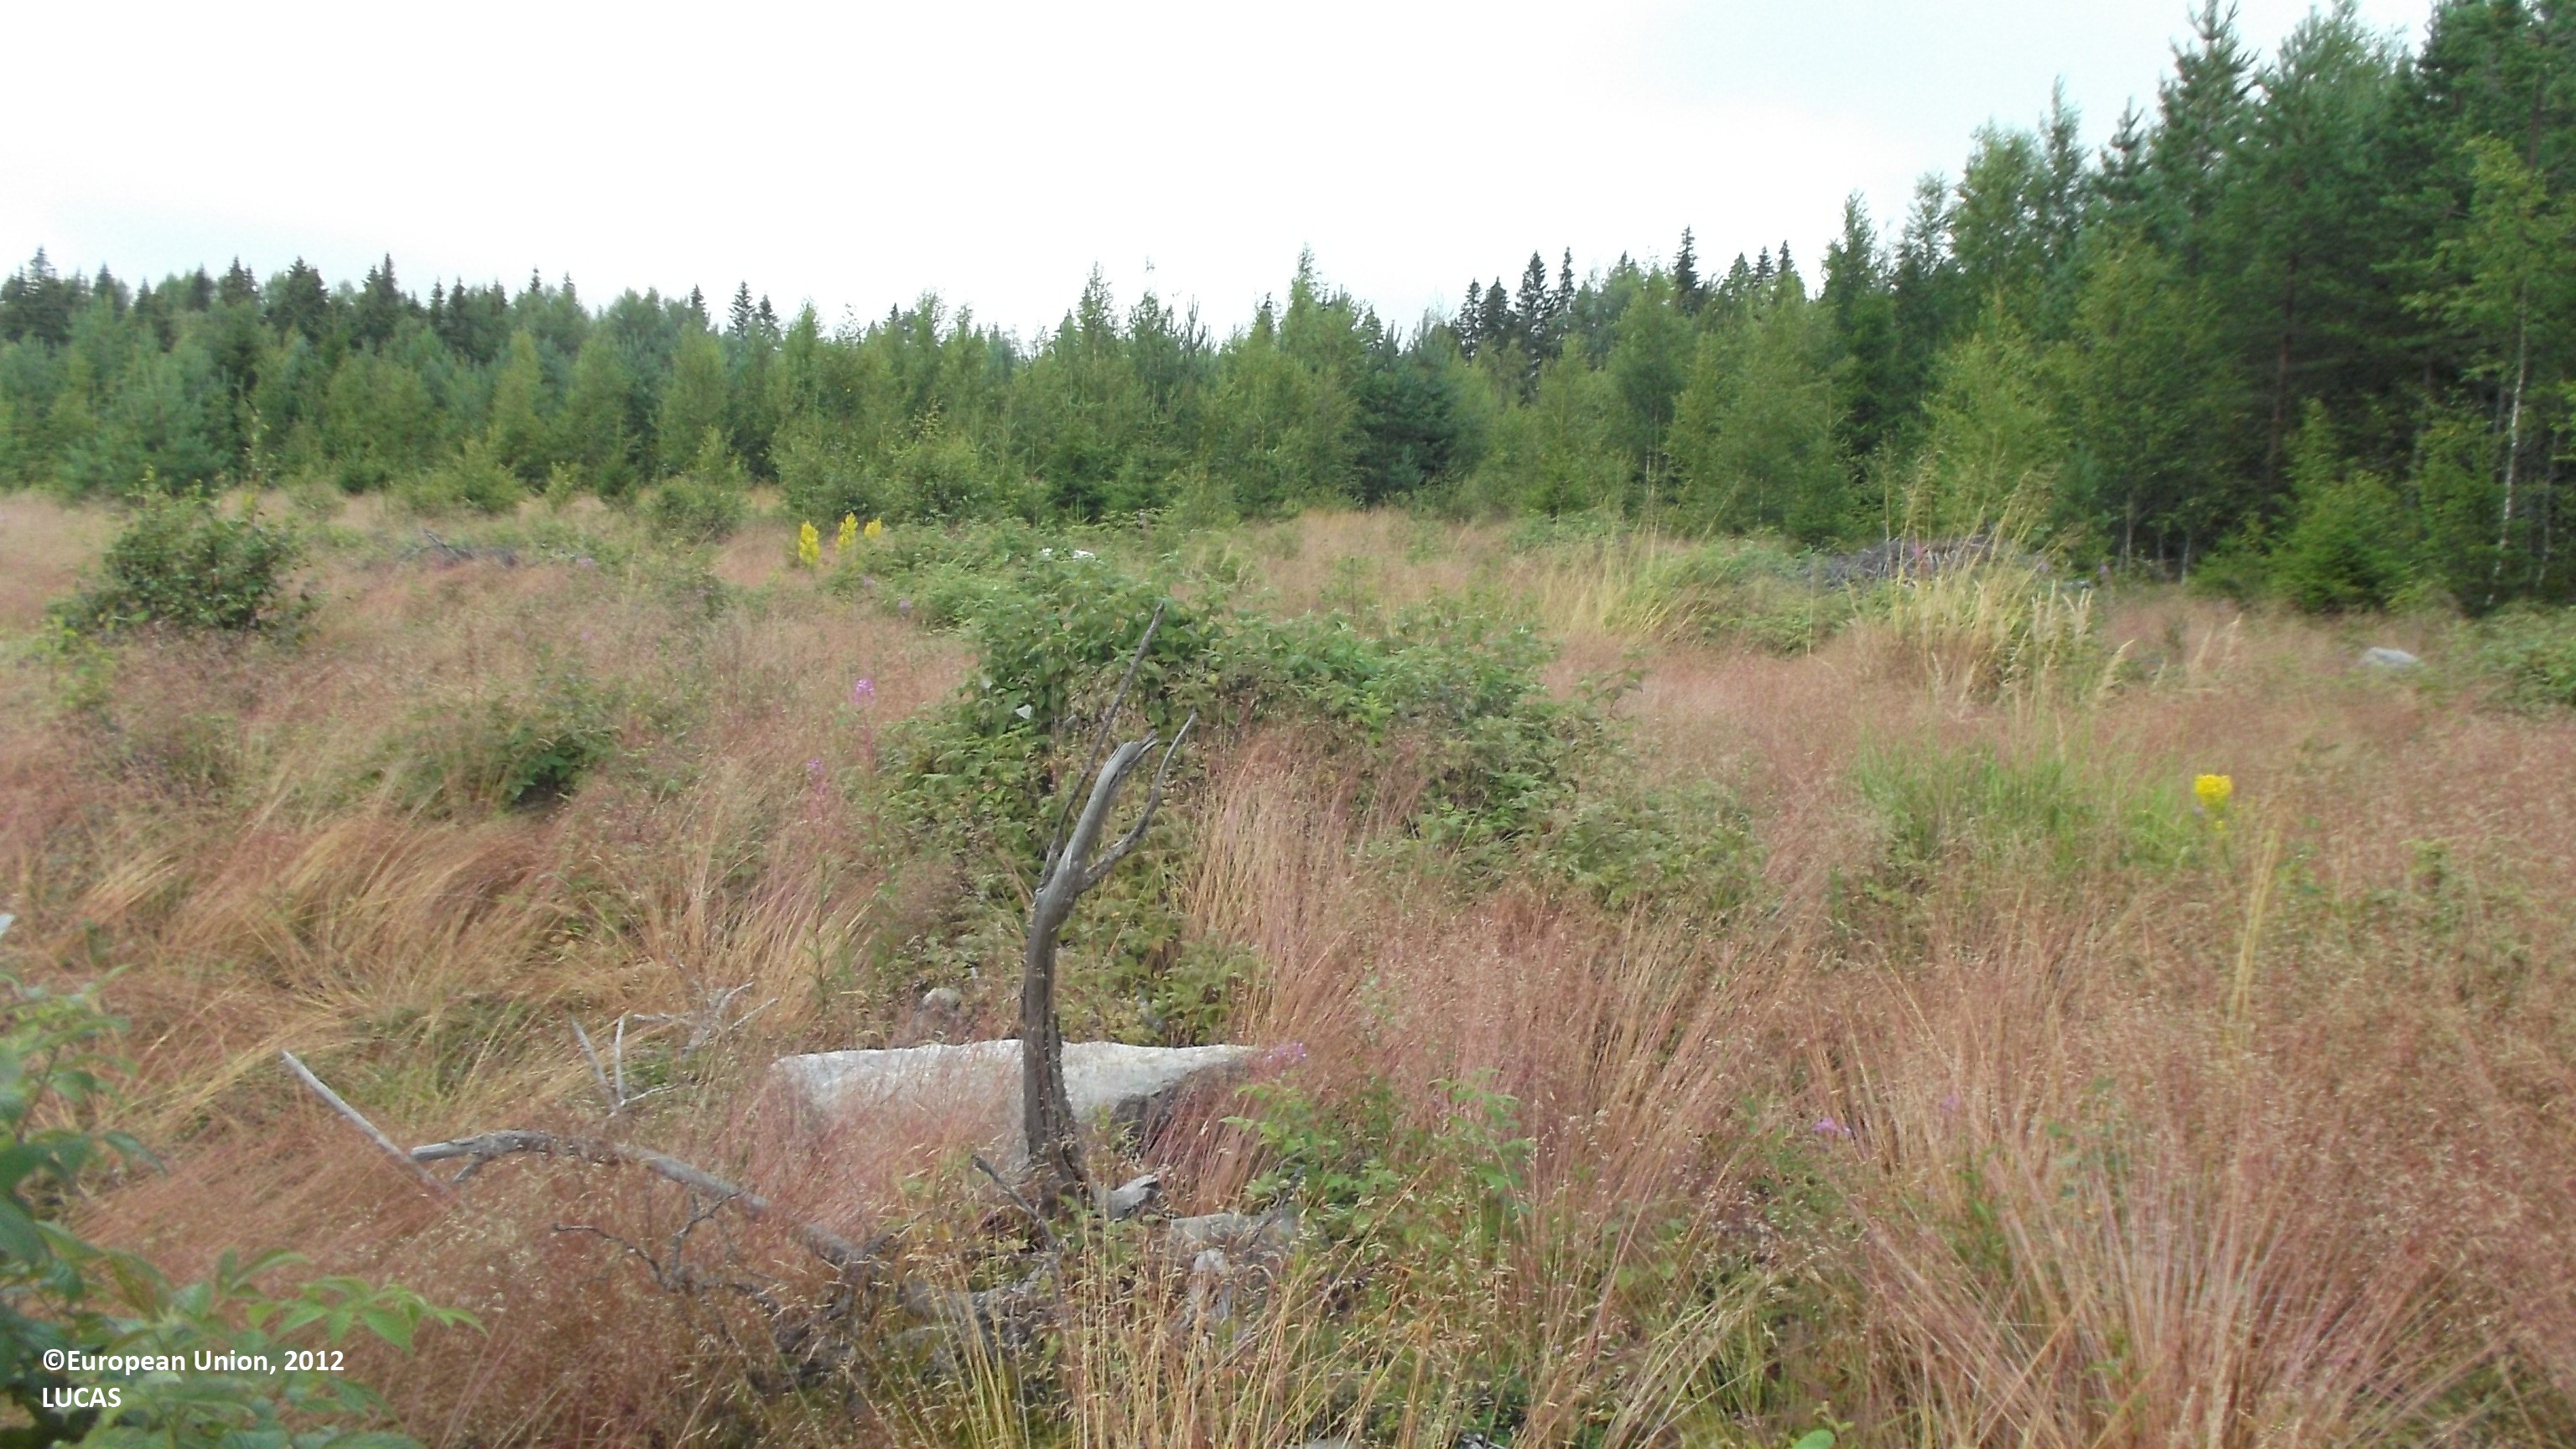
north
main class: Grassland
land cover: Grassland without tree/shrub cover
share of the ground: 50 - 75 %
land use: Forestry
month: August
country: FI
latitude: 63.8648
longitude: 23.3842
